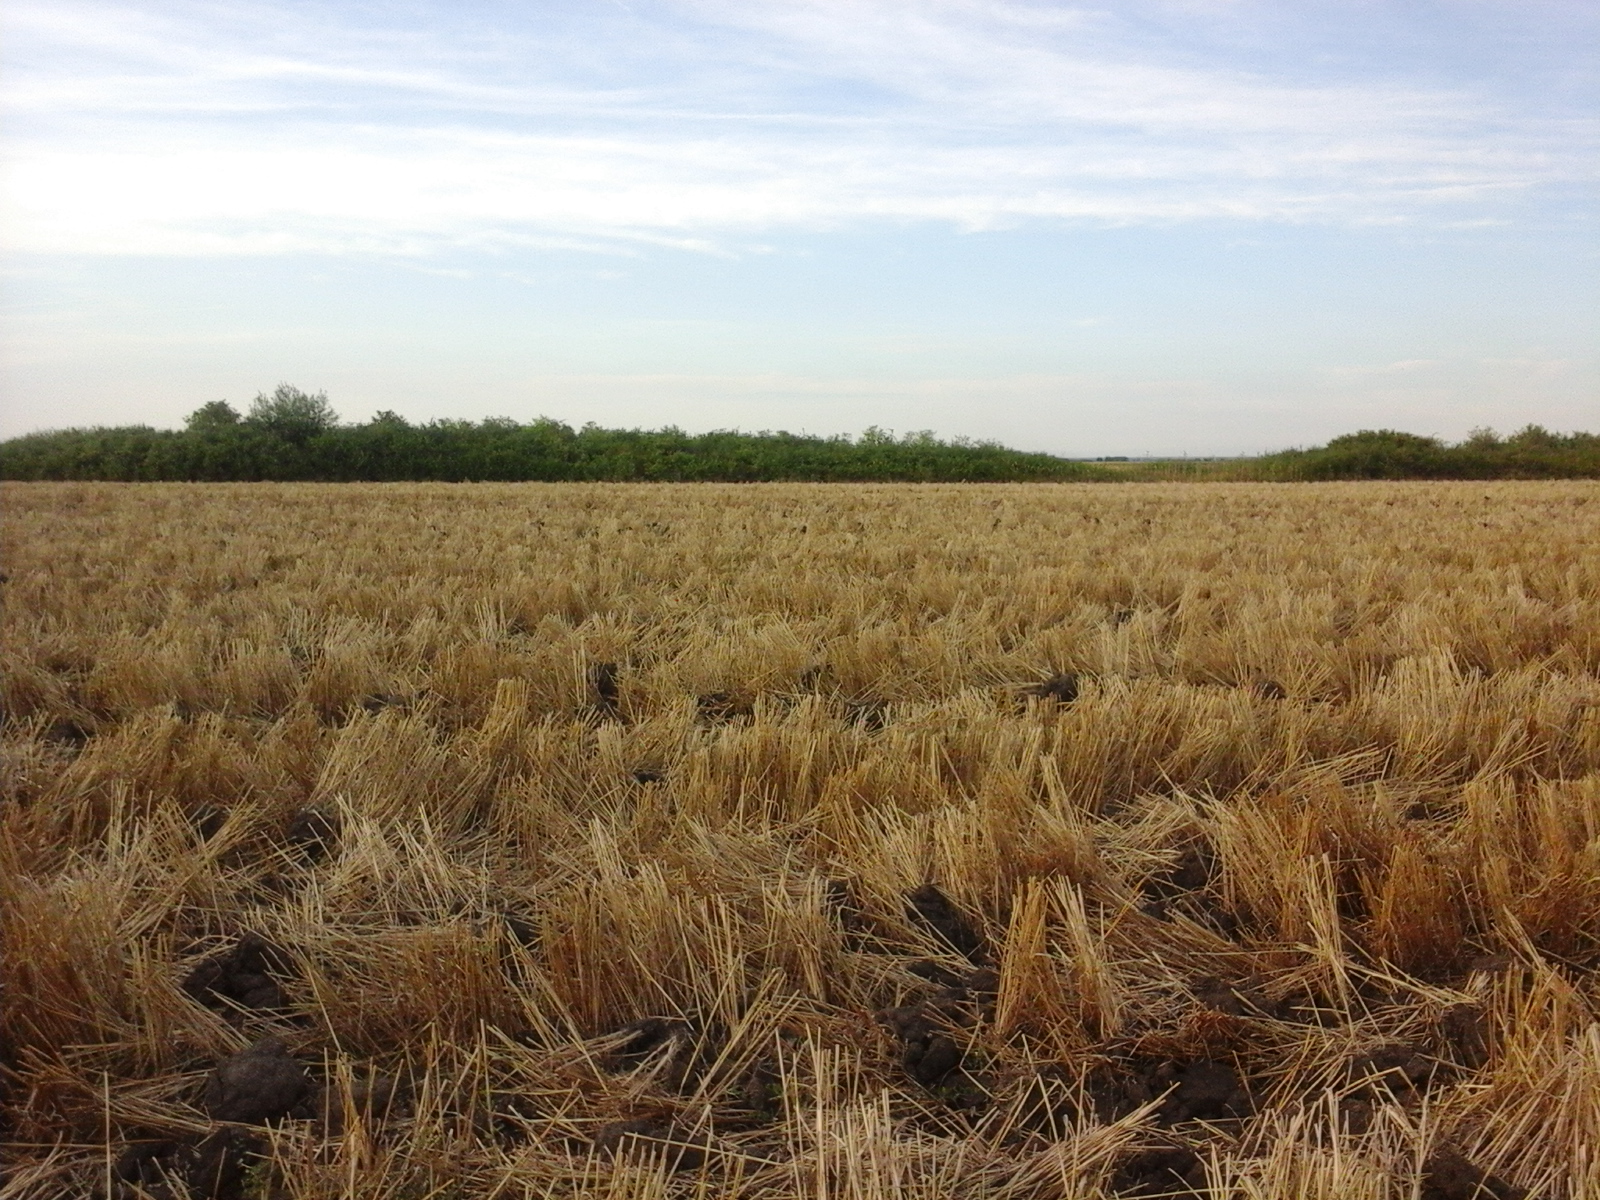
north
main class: Cropland
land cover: Common wheat
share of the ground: 25 - 50 %
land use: Agriculture (excluding fallow land and kitchen gardens)
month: August
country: RO
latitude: 45.2560
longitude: 21.3316
